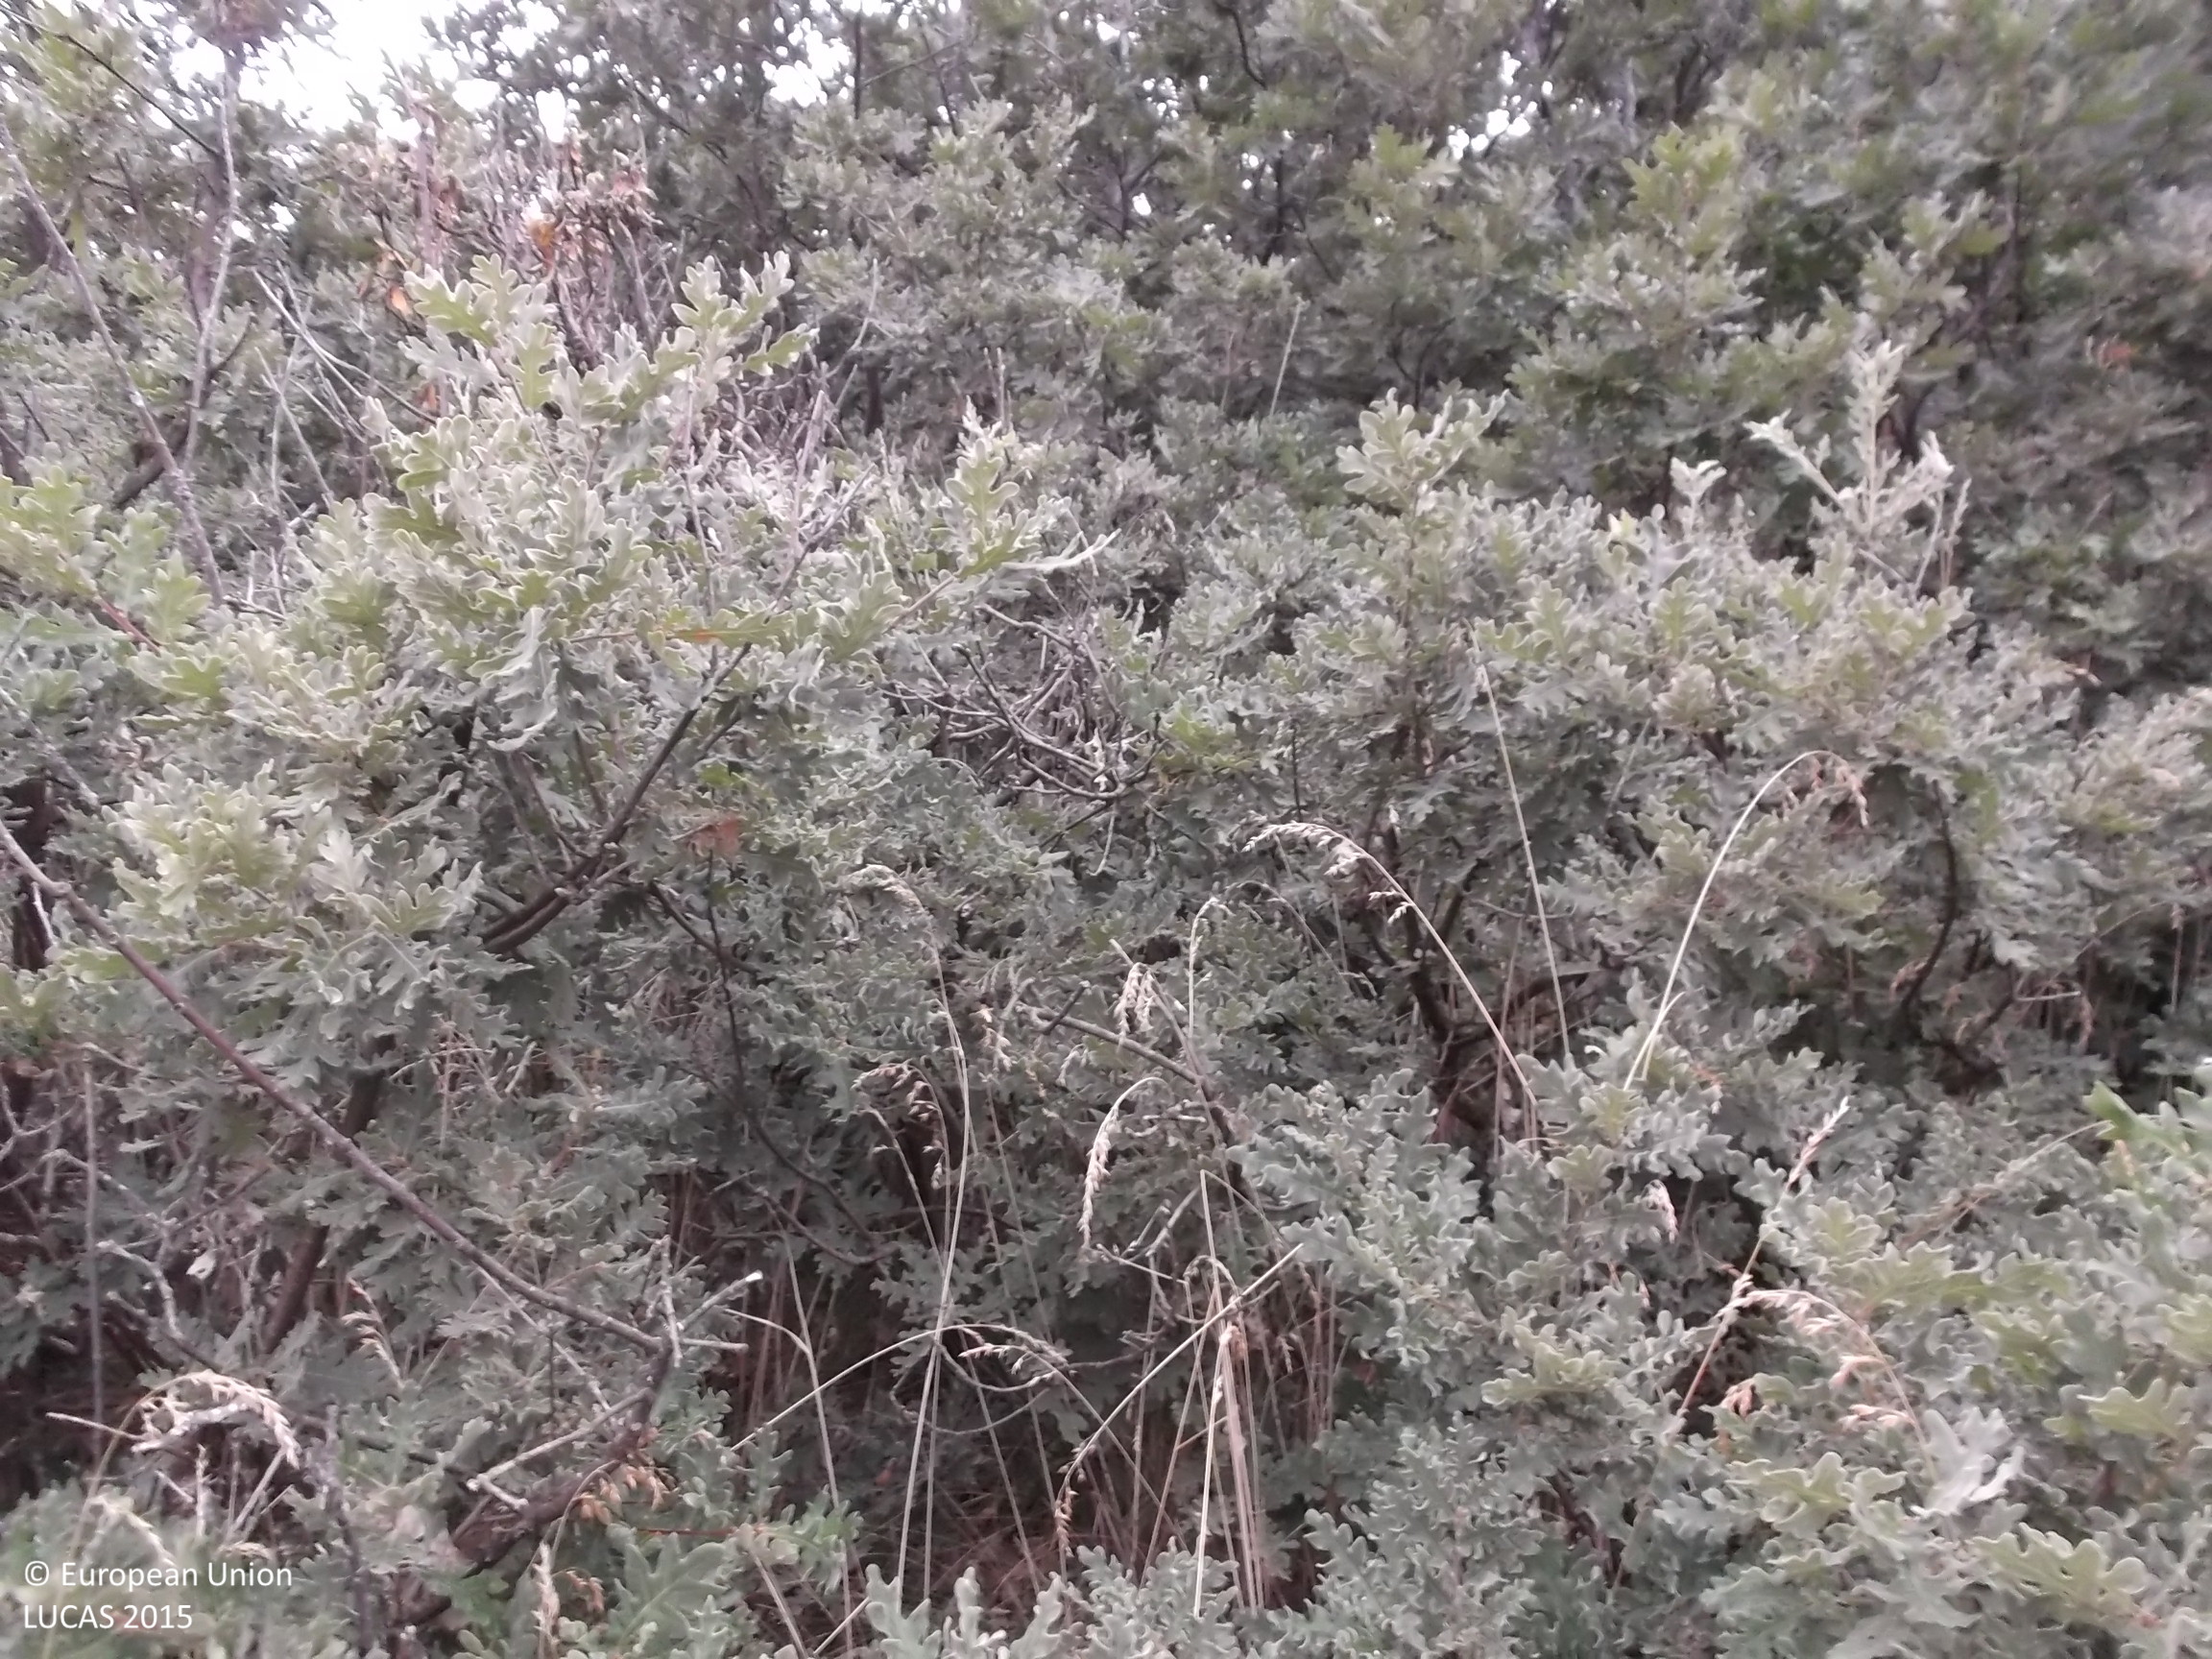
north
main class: Woodland
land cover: Broadleaved woodland
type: thermophilous deciduous forest
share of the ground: > 75 %
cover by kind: broadleaved forest trees 90 %, shrubs 10 %
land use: Forestry
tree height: > 5 m
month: July
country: ES
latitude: 42.0529
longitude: -2.2542
